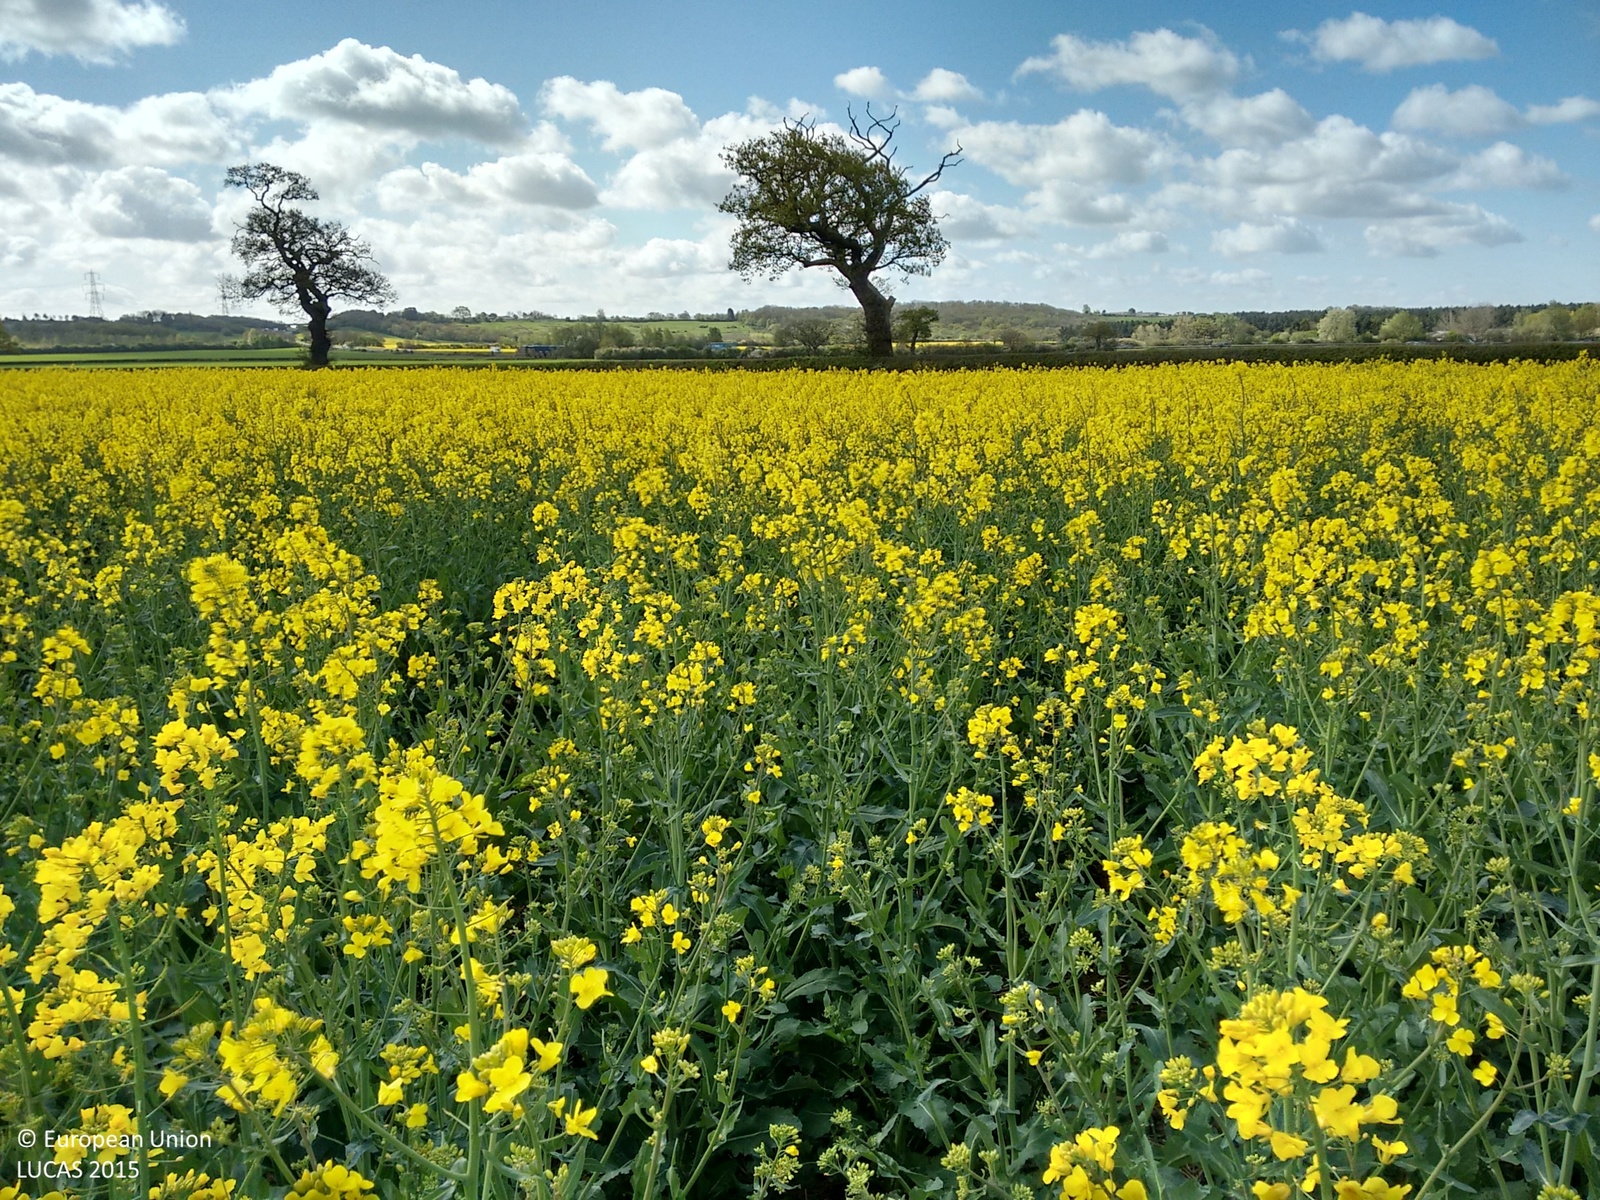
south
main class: Cropland
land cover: Rape and turnip rape
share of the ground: > 75 %
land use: Agriculture (excluding fallow land and kitchen gardens)
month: April
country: GB
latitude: 51.8351
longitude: -1.1190
